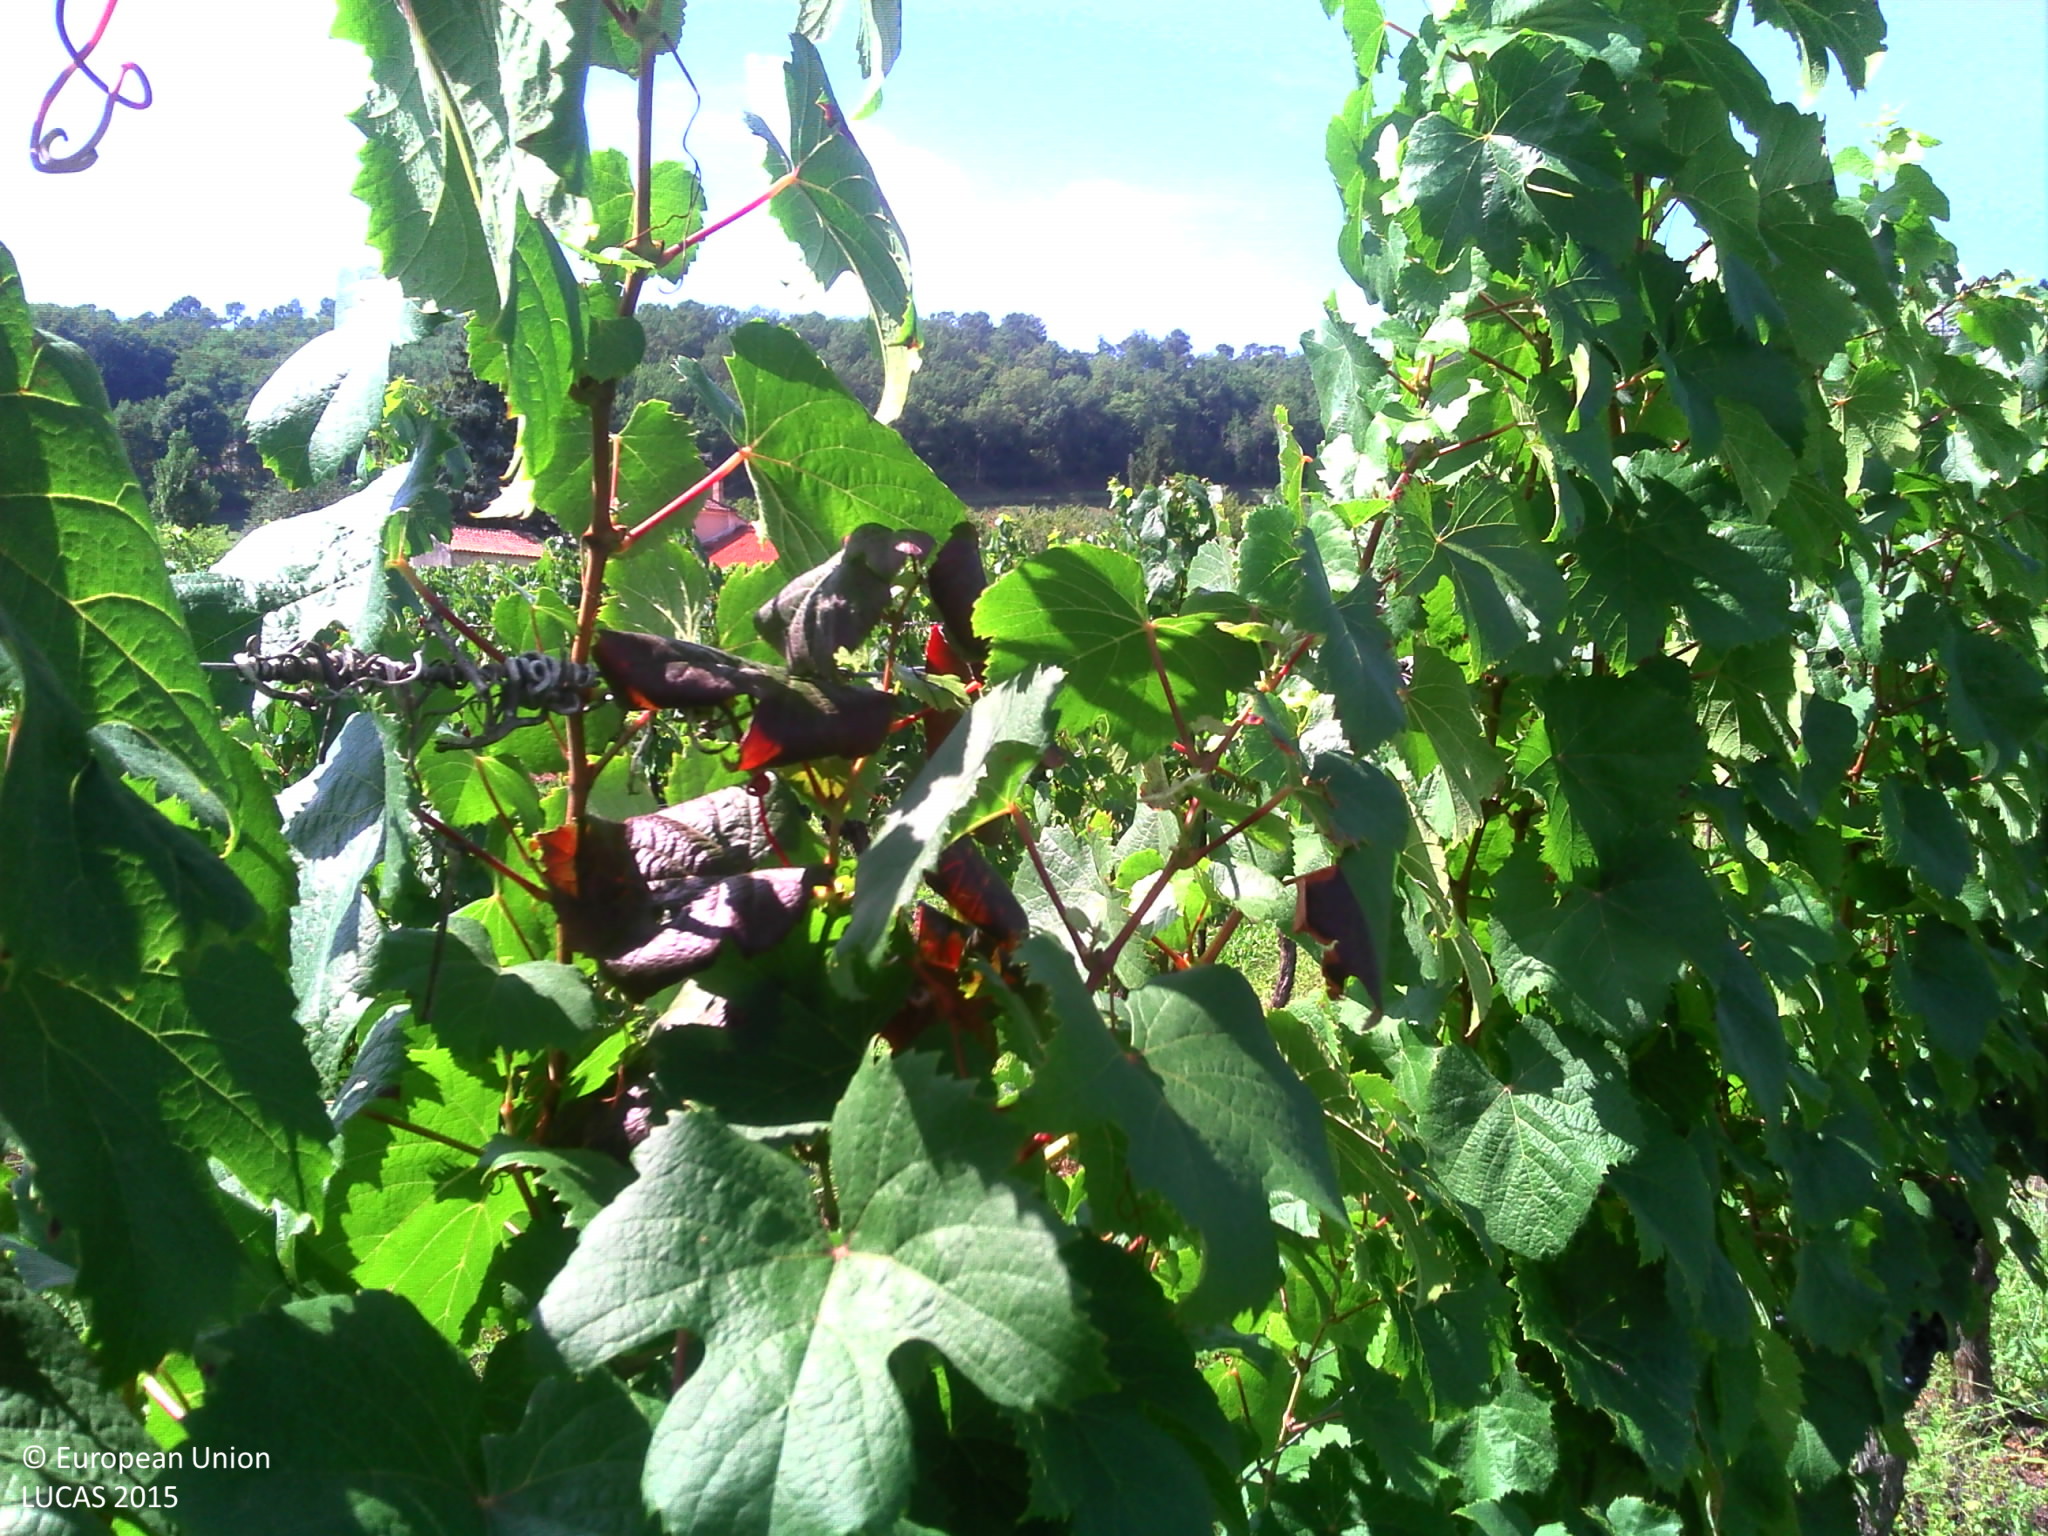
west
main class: Cropland
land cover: Vineyards
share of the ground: 25 - 50 %
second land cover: Grassland without tree/shrub cover
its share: 50 - 75 %
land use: Agriculture (excluding fallow land and kitchen gardens)
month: August
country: FR
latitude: 44.5181
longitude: 1.1772
